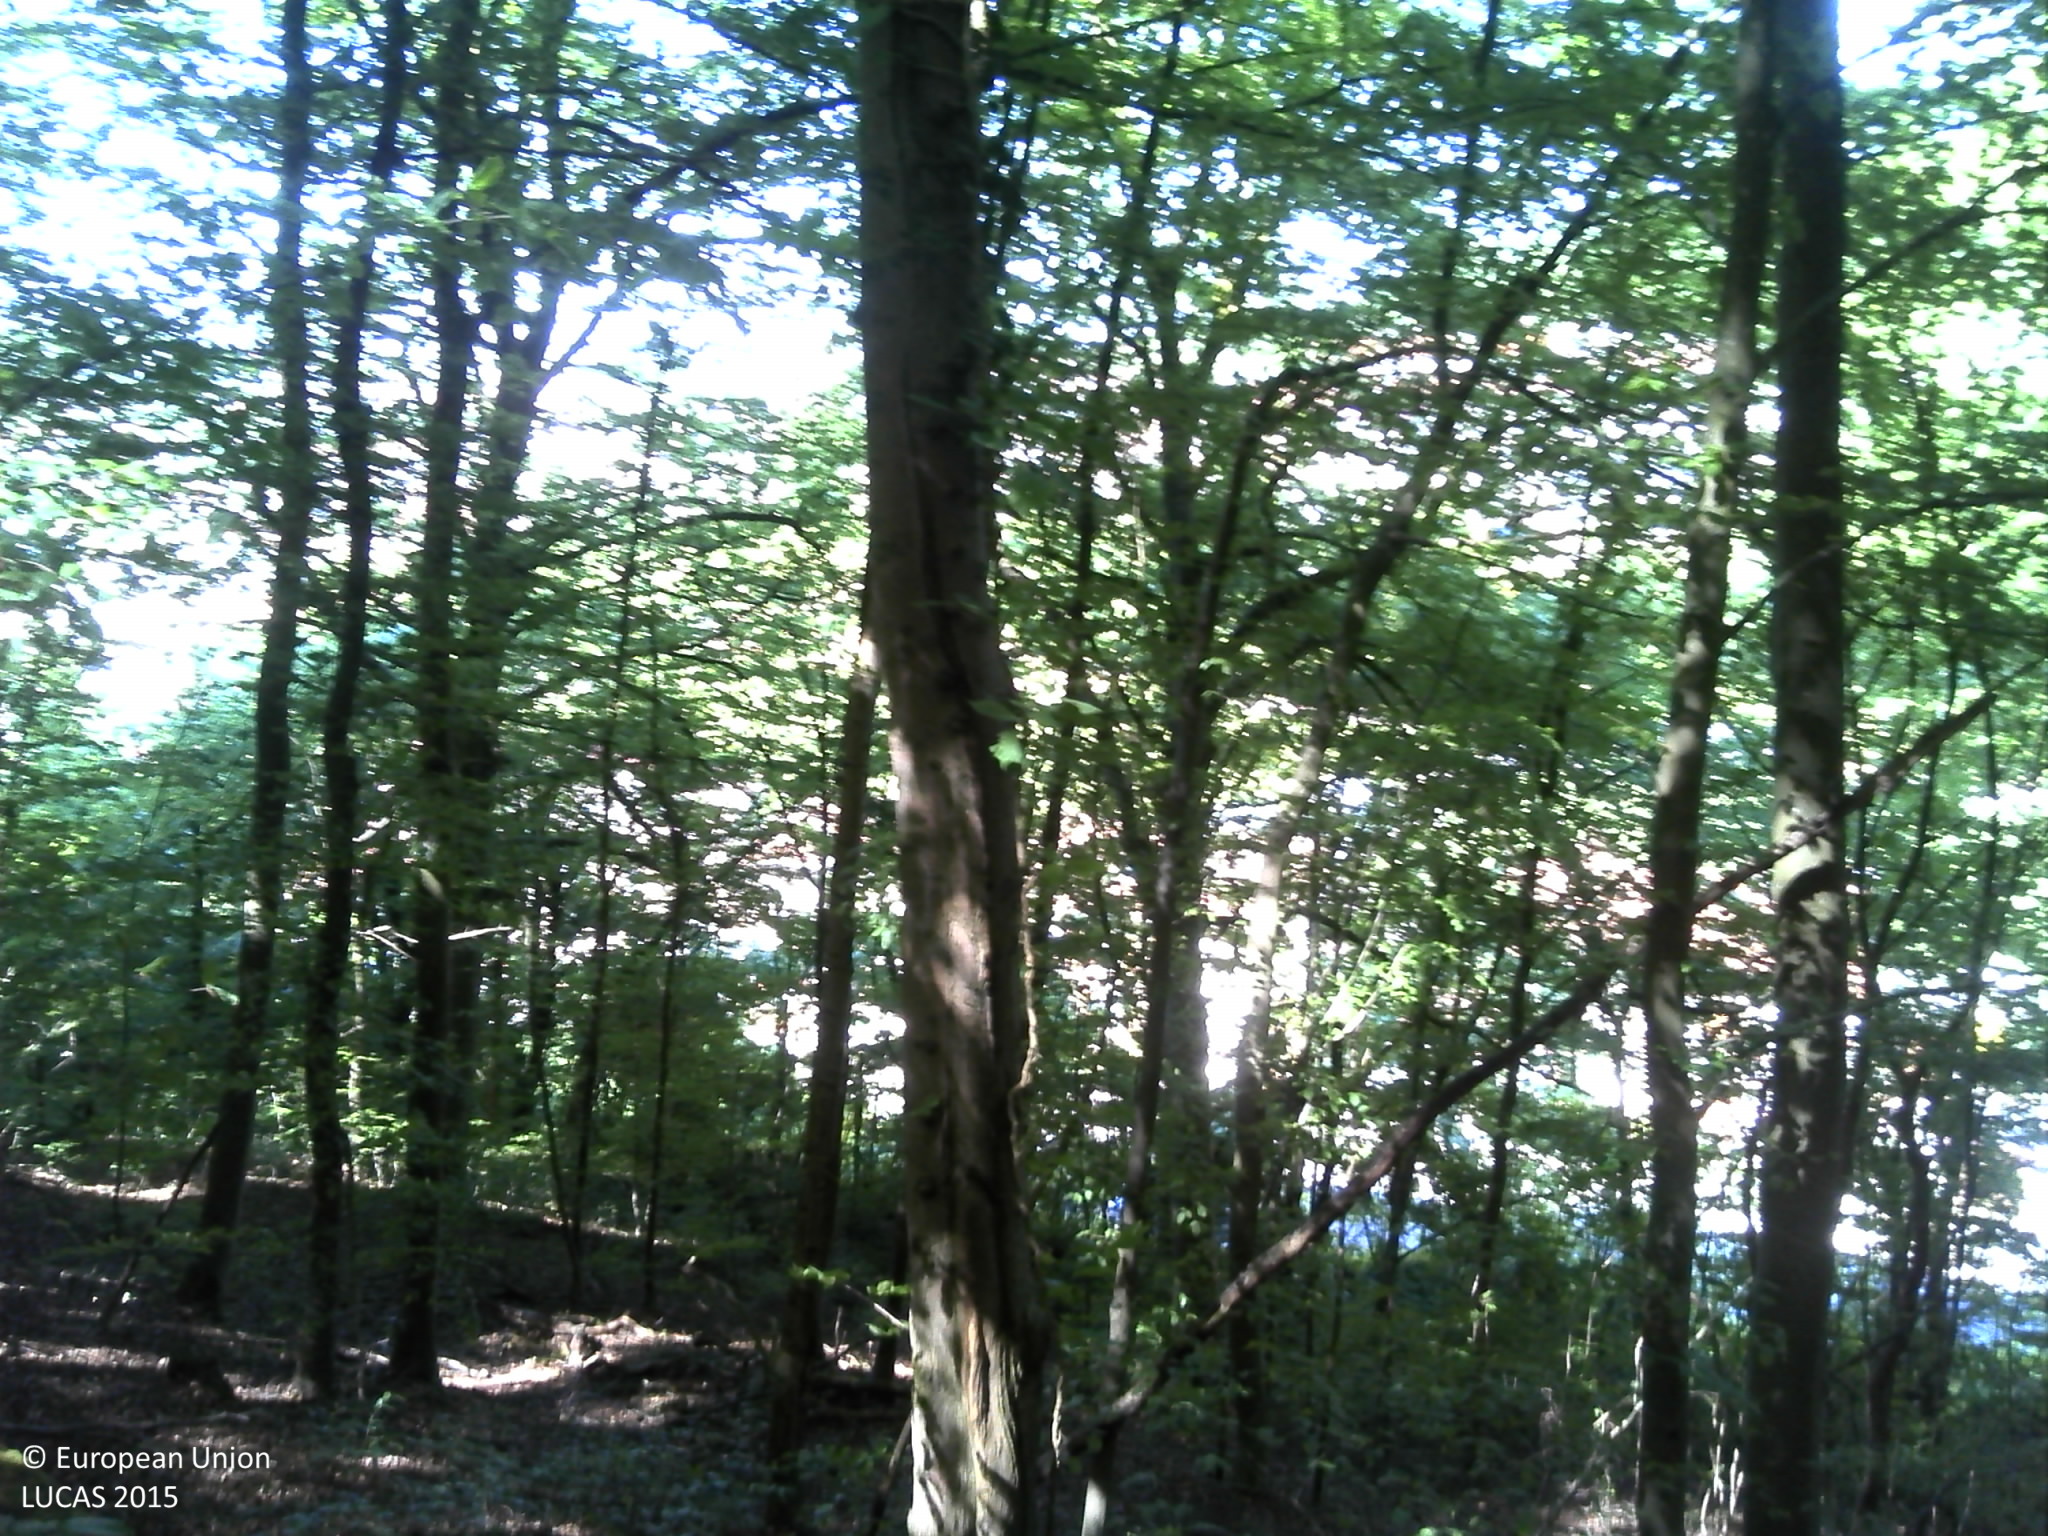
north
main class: Woodland
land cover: Broadleaved woodland
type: acidophilous oak and oak-birch forest
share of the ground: > 75 %
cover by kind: broadleaved forest trees 100 %
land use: Forestry
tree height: > 5 m
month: June
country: FR
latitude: 49.4643
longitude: 5.9565
